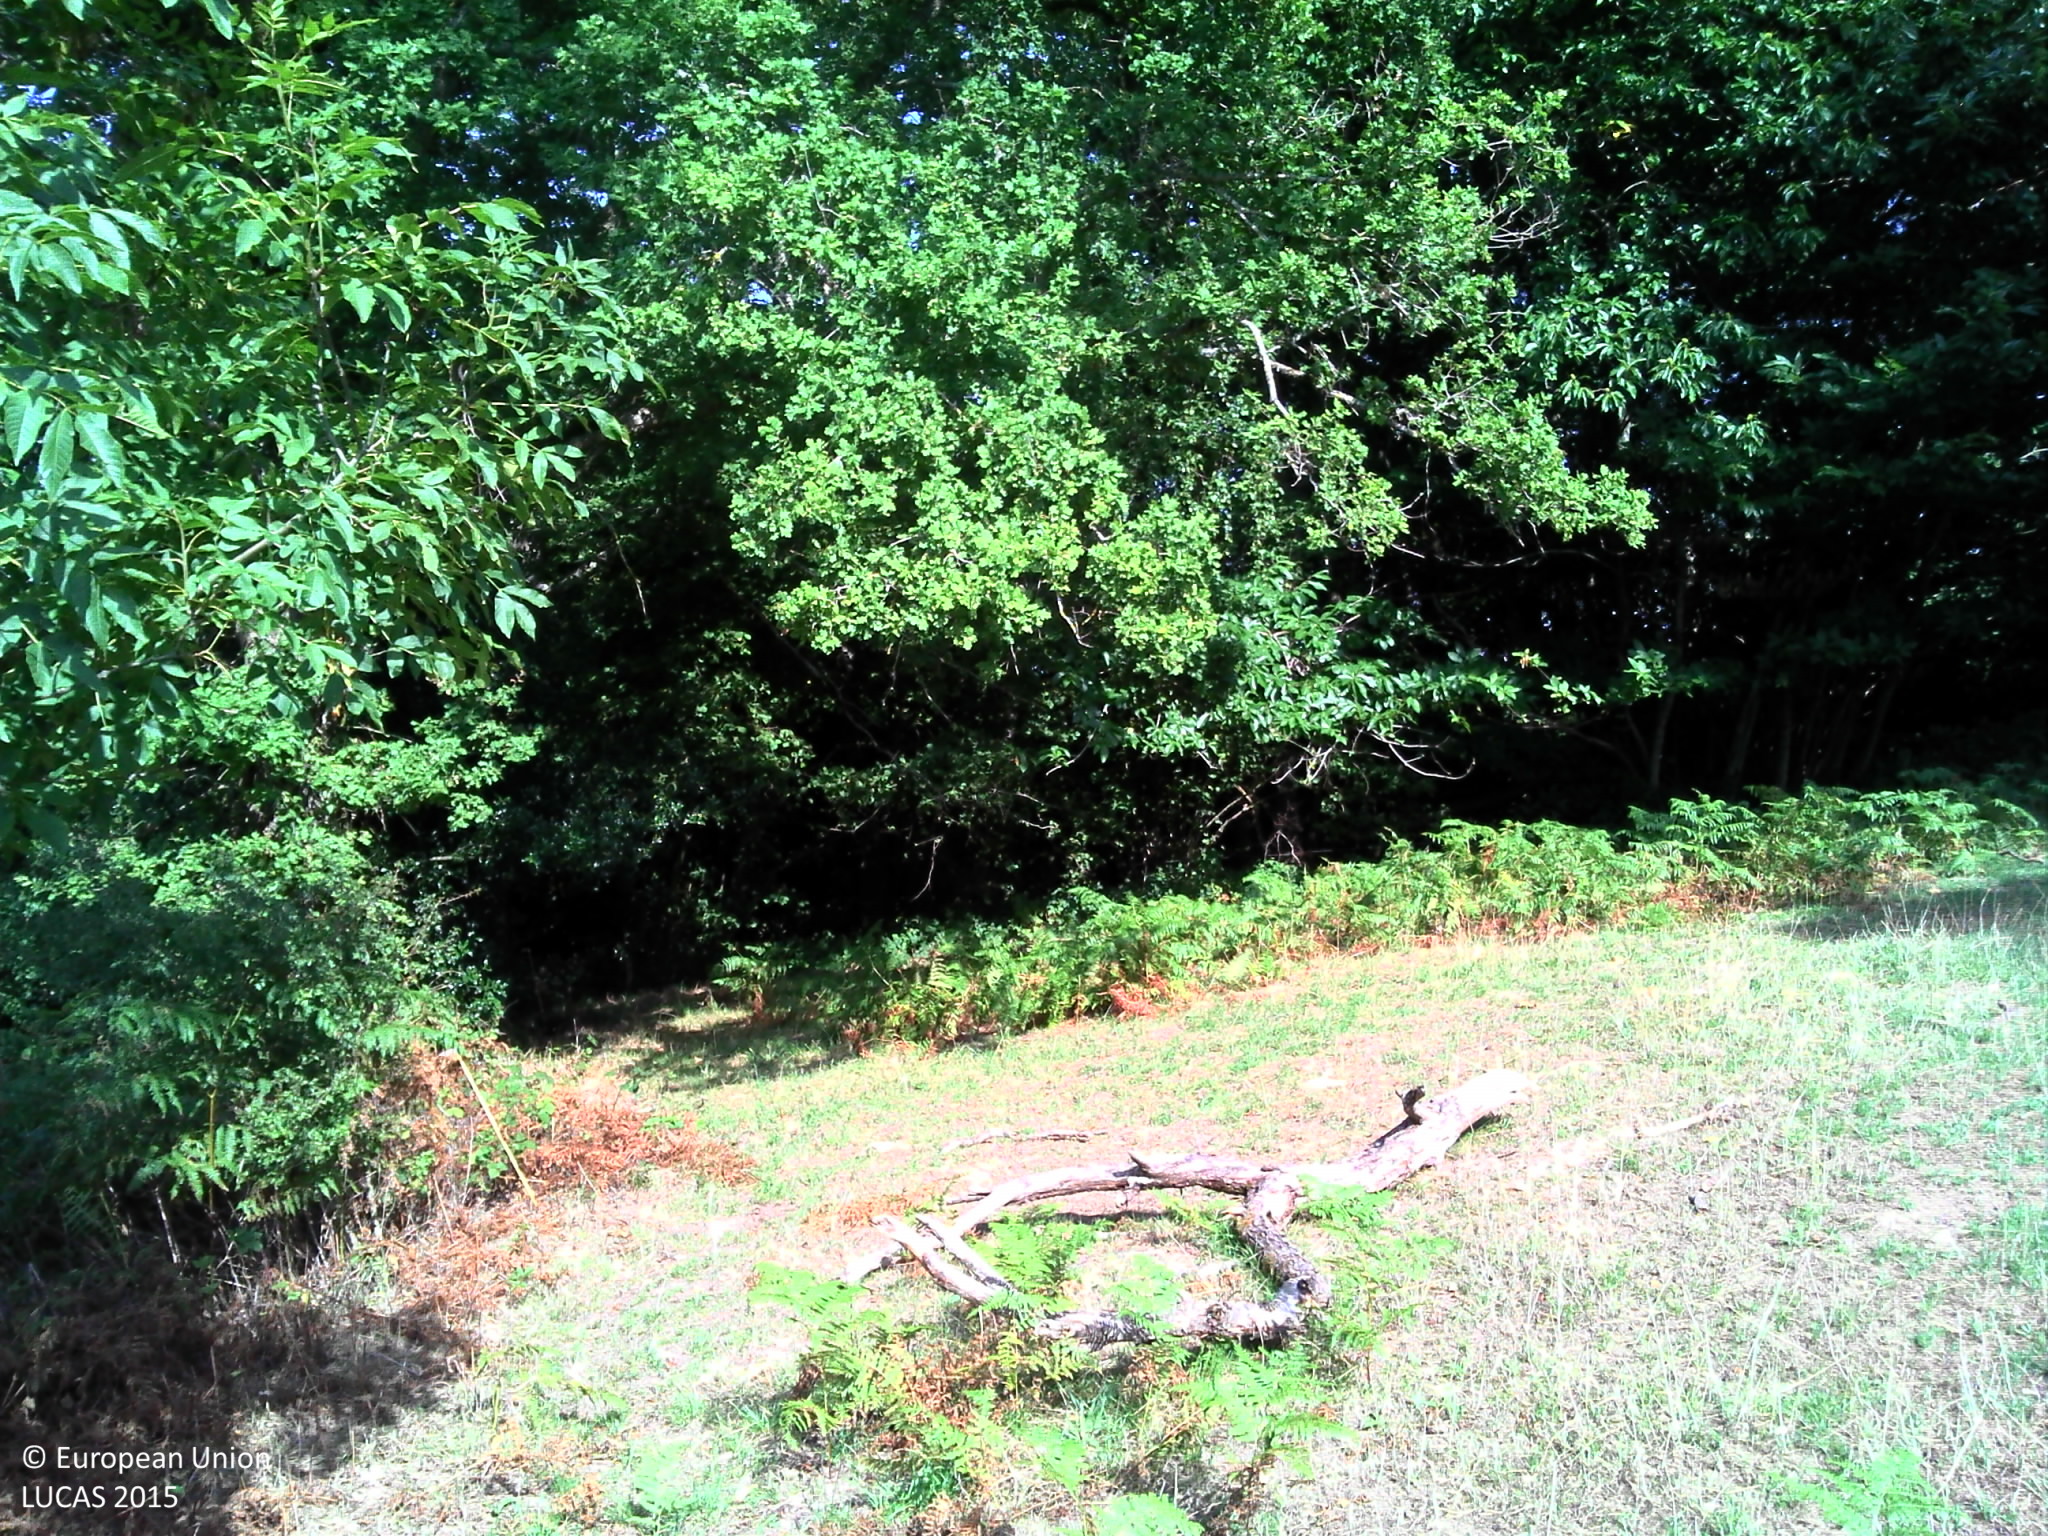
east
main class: Grassland
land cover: Grassland with sparse tree/shrub cover
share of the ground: > 75 %
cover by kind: herbaceous plants 90 %, broadleaved forest trees 5 %, shrubs 5 %
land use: Agriculture (excluding fallow land and kitchen gardens)
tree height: > 5 m
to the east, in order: Grassland with sparse tree/shrub cover; Fences; Broadleaved woodland; Fences; Spontaneously vegetated surfaces; Grassland without tree/shrub cover; Fences; Broadleaved woodland; Fences; Grassland without tree/shrub cover; Ditches and canals; Grassland without tree/shrub cover; Fences; Broadleaved woodland; Spontaneously vegetated surfaces; Fences; Grassland without tree/shrub cover
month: August
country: FR
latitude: 46.2686
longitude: 2.2484
